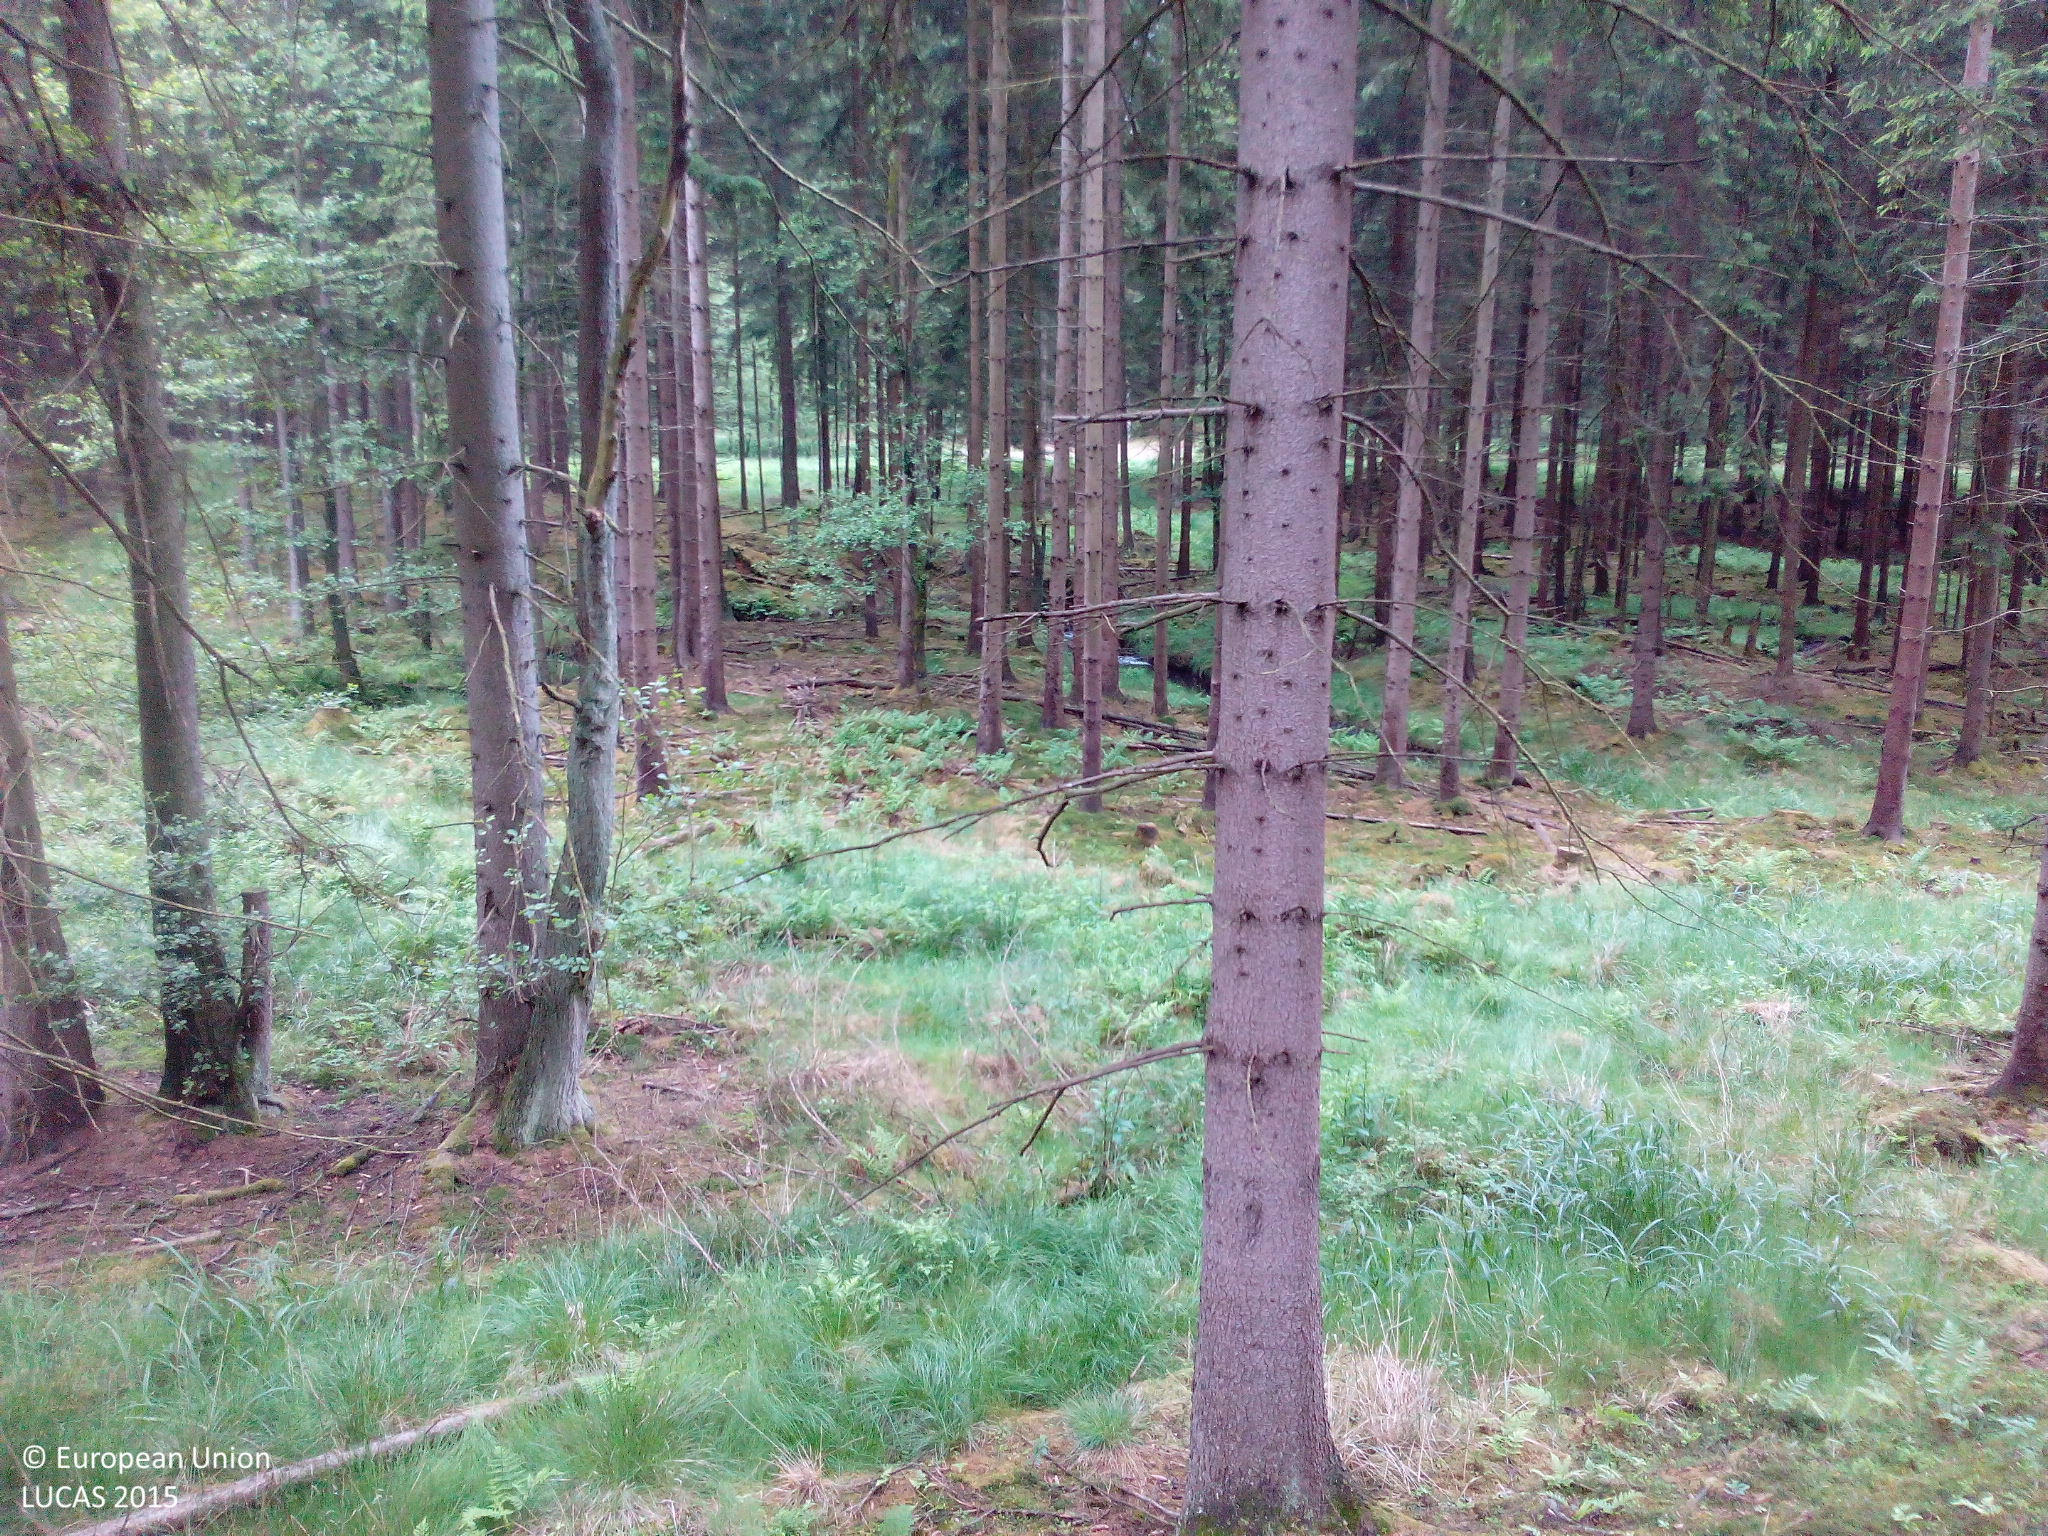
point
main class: Woodland
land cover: Spruce dominated coniferous woodland
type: hemiboreal forest and nemoral coniferous forest and mixed broadleaved-coniferous forest
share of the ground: > 75 %
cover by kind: coniferous forest trees 95 %, broadleaved forest trees 5 %
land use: Forestry
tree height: > 5 m
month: June
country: DE
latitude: 51.4700
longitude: 8.5752
